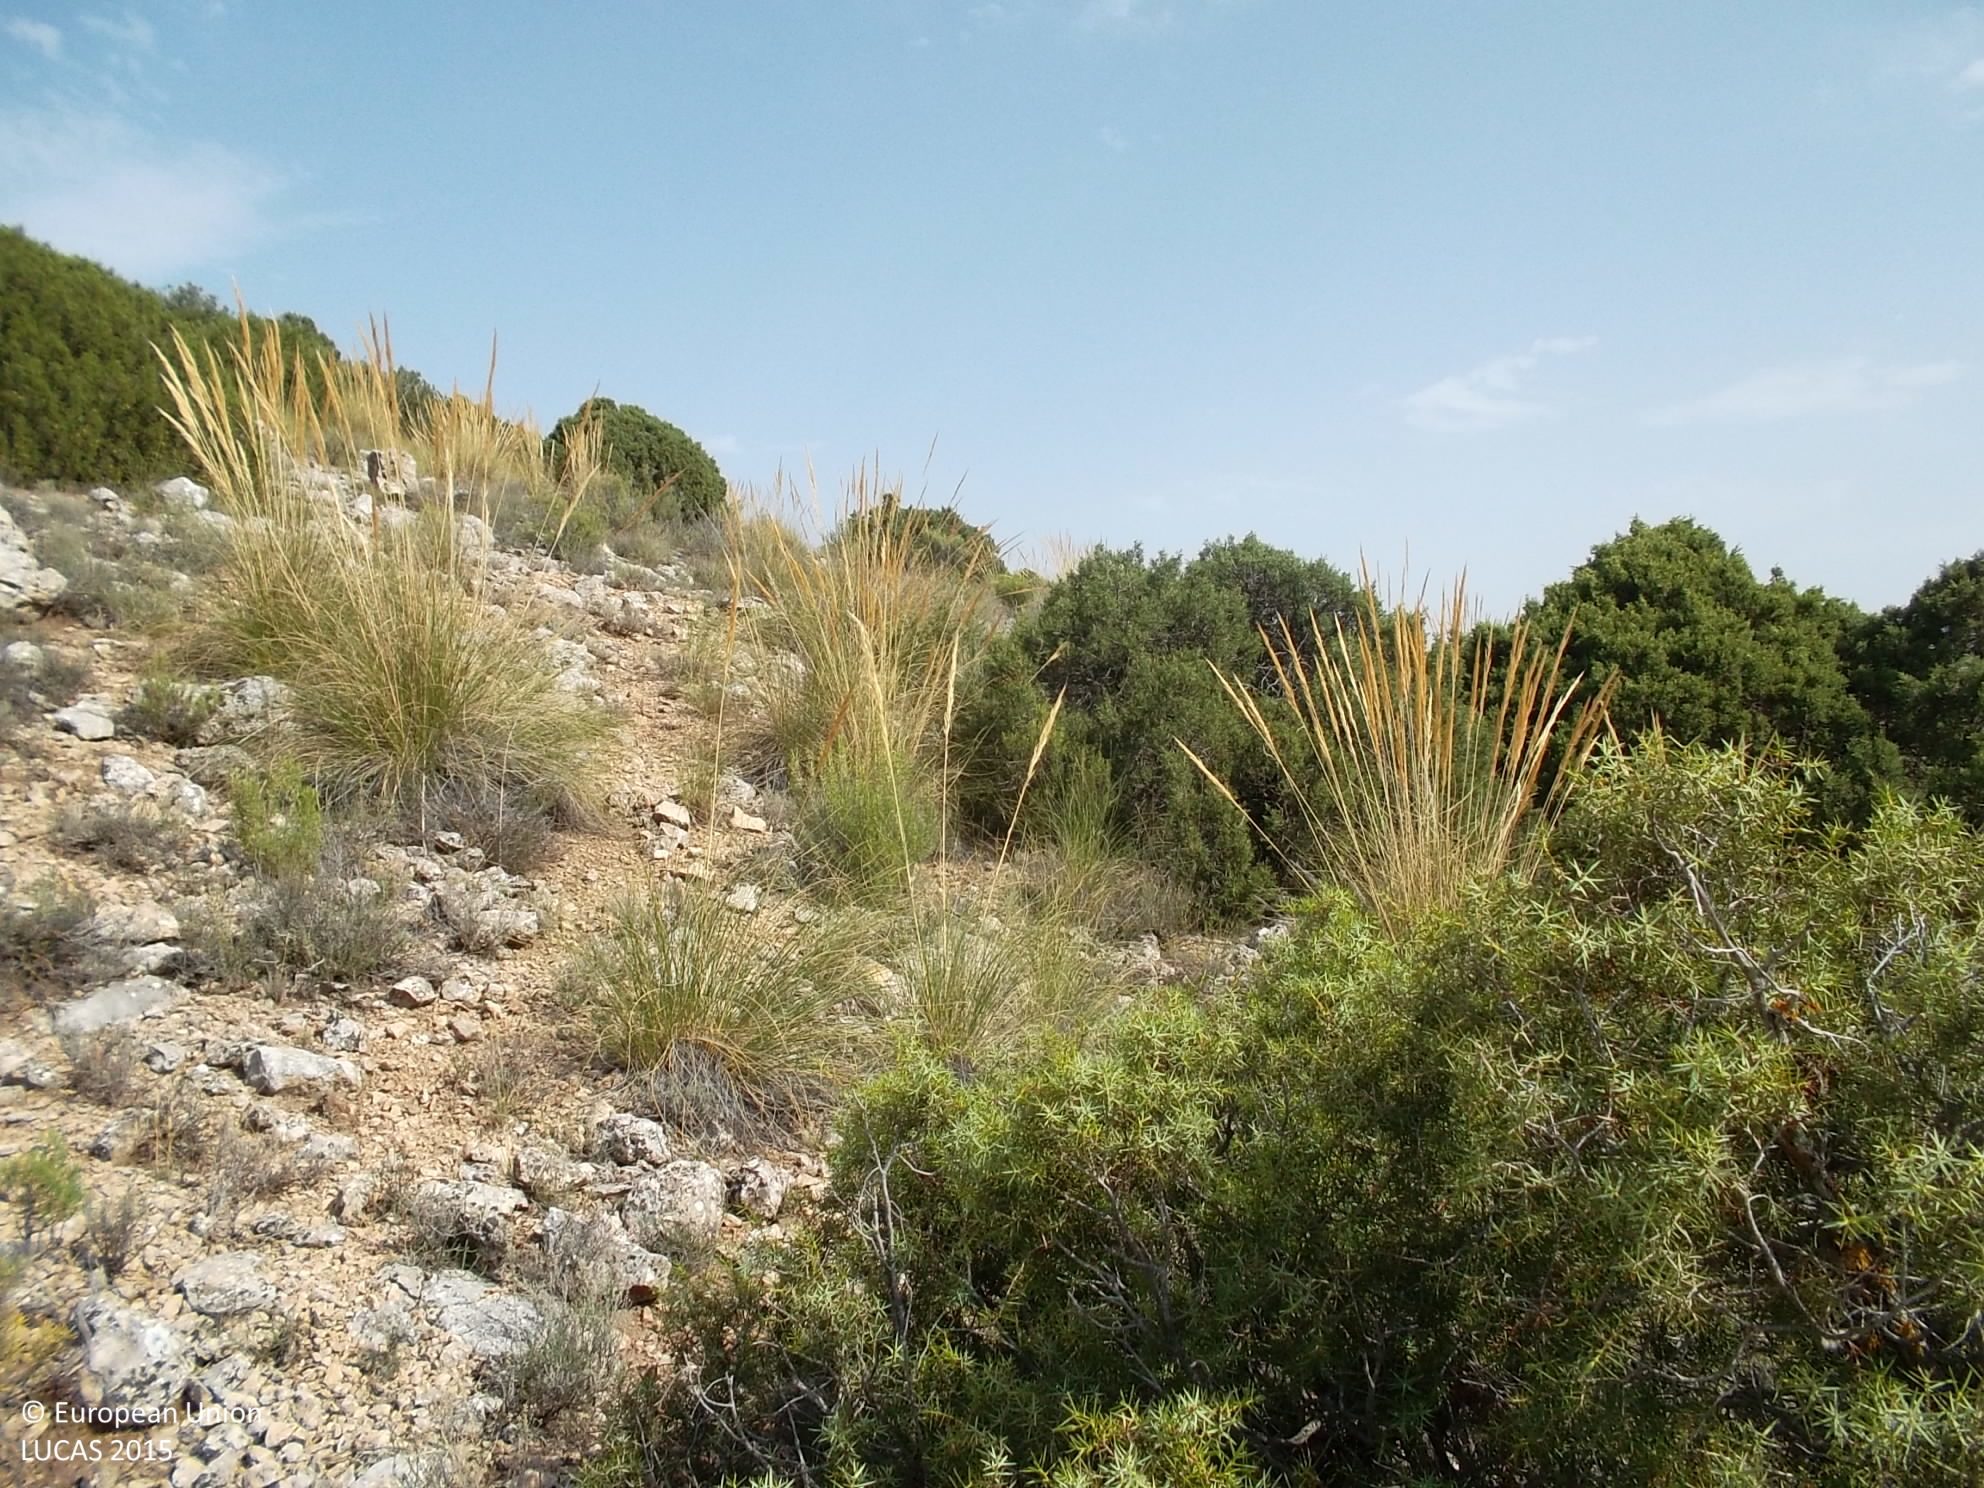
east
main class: Shrubland
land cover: Shrubland without tree cover
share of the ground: 50 - 75 %
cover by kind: shrubs 60 %, herbaceous plants 20 %, consolidated bare surface 20 %
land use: Semi-natural and natural areas not in use
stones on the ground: 25 - 50 %
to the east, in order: Shrubland without tree cover; Rock outcrops; Shrubland without tree cover
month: July
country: ES
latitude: 37.8980
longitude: -2.4430
